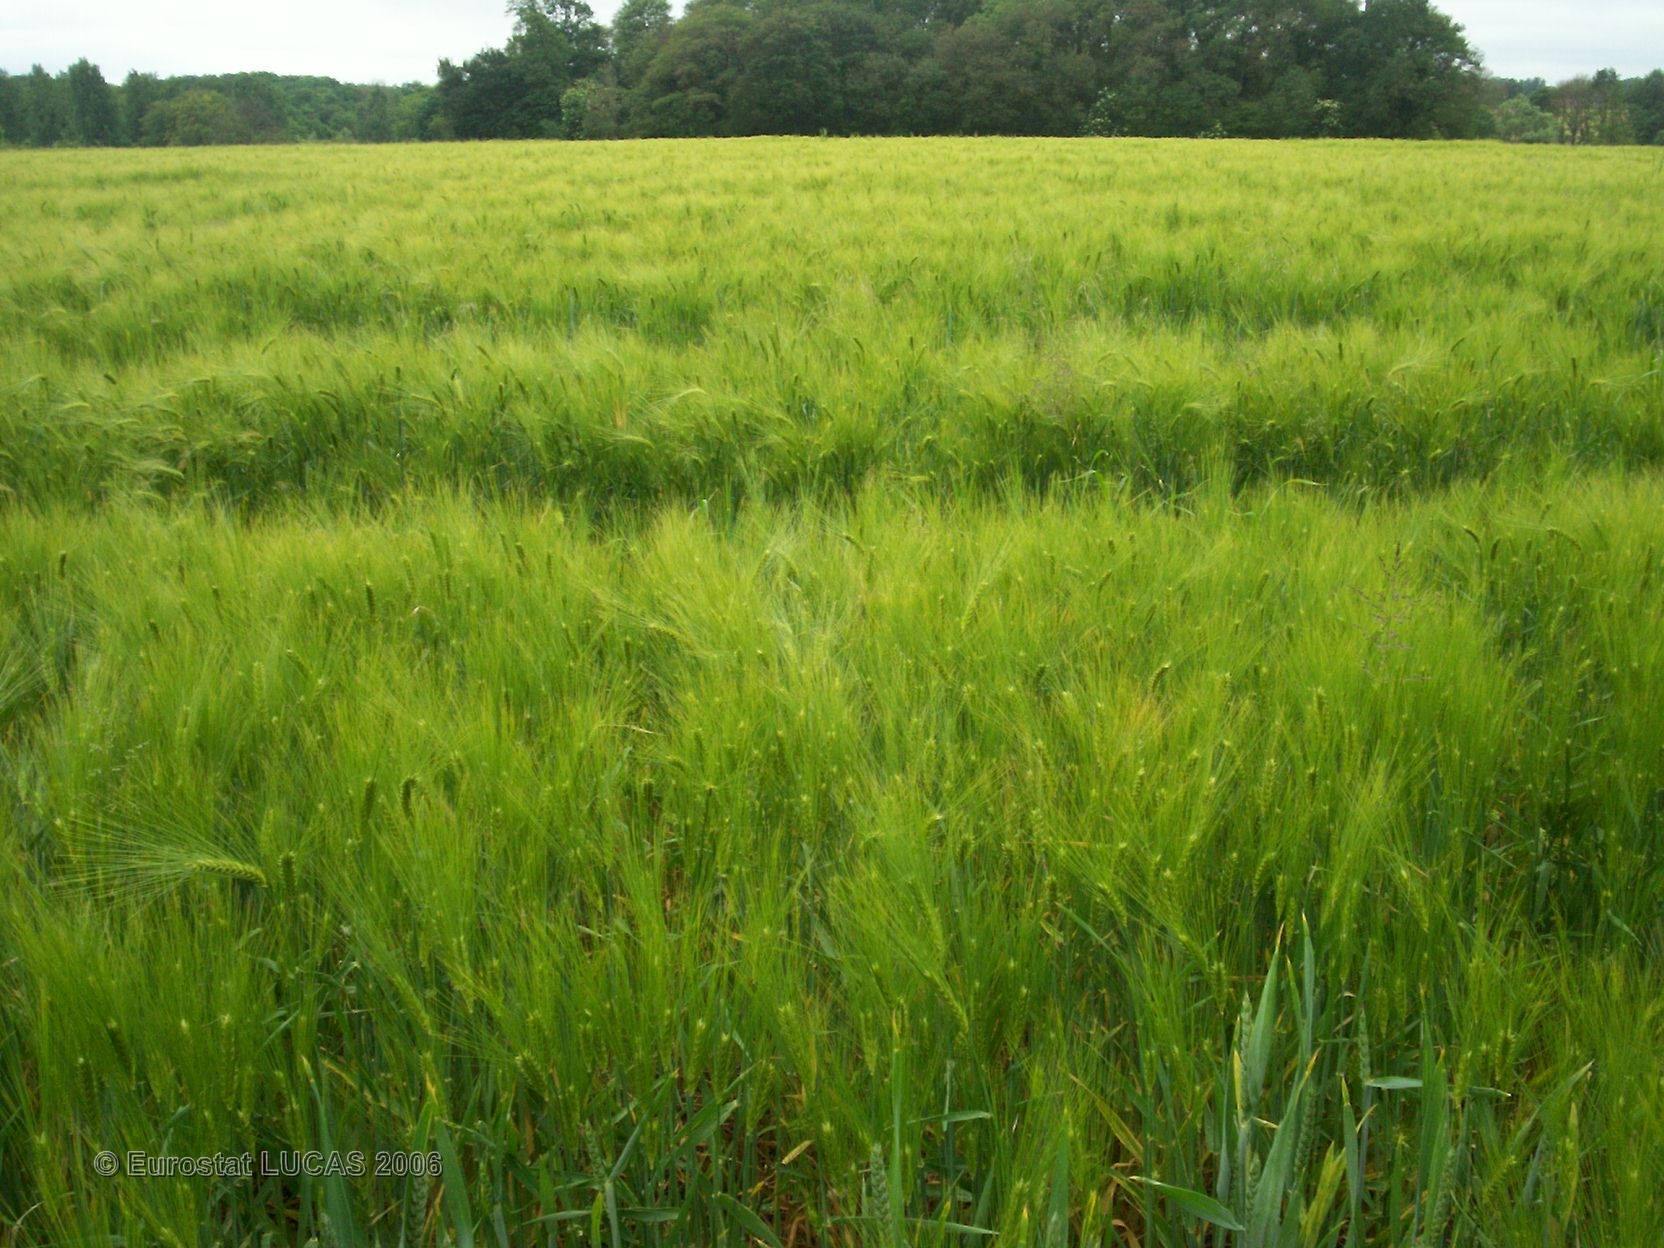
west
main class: Cropland
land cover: Barley
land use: Agriculture (excluding fallow land and kitchen gardens)
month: May
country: FR
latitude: 46.2919
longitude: 0.5206
